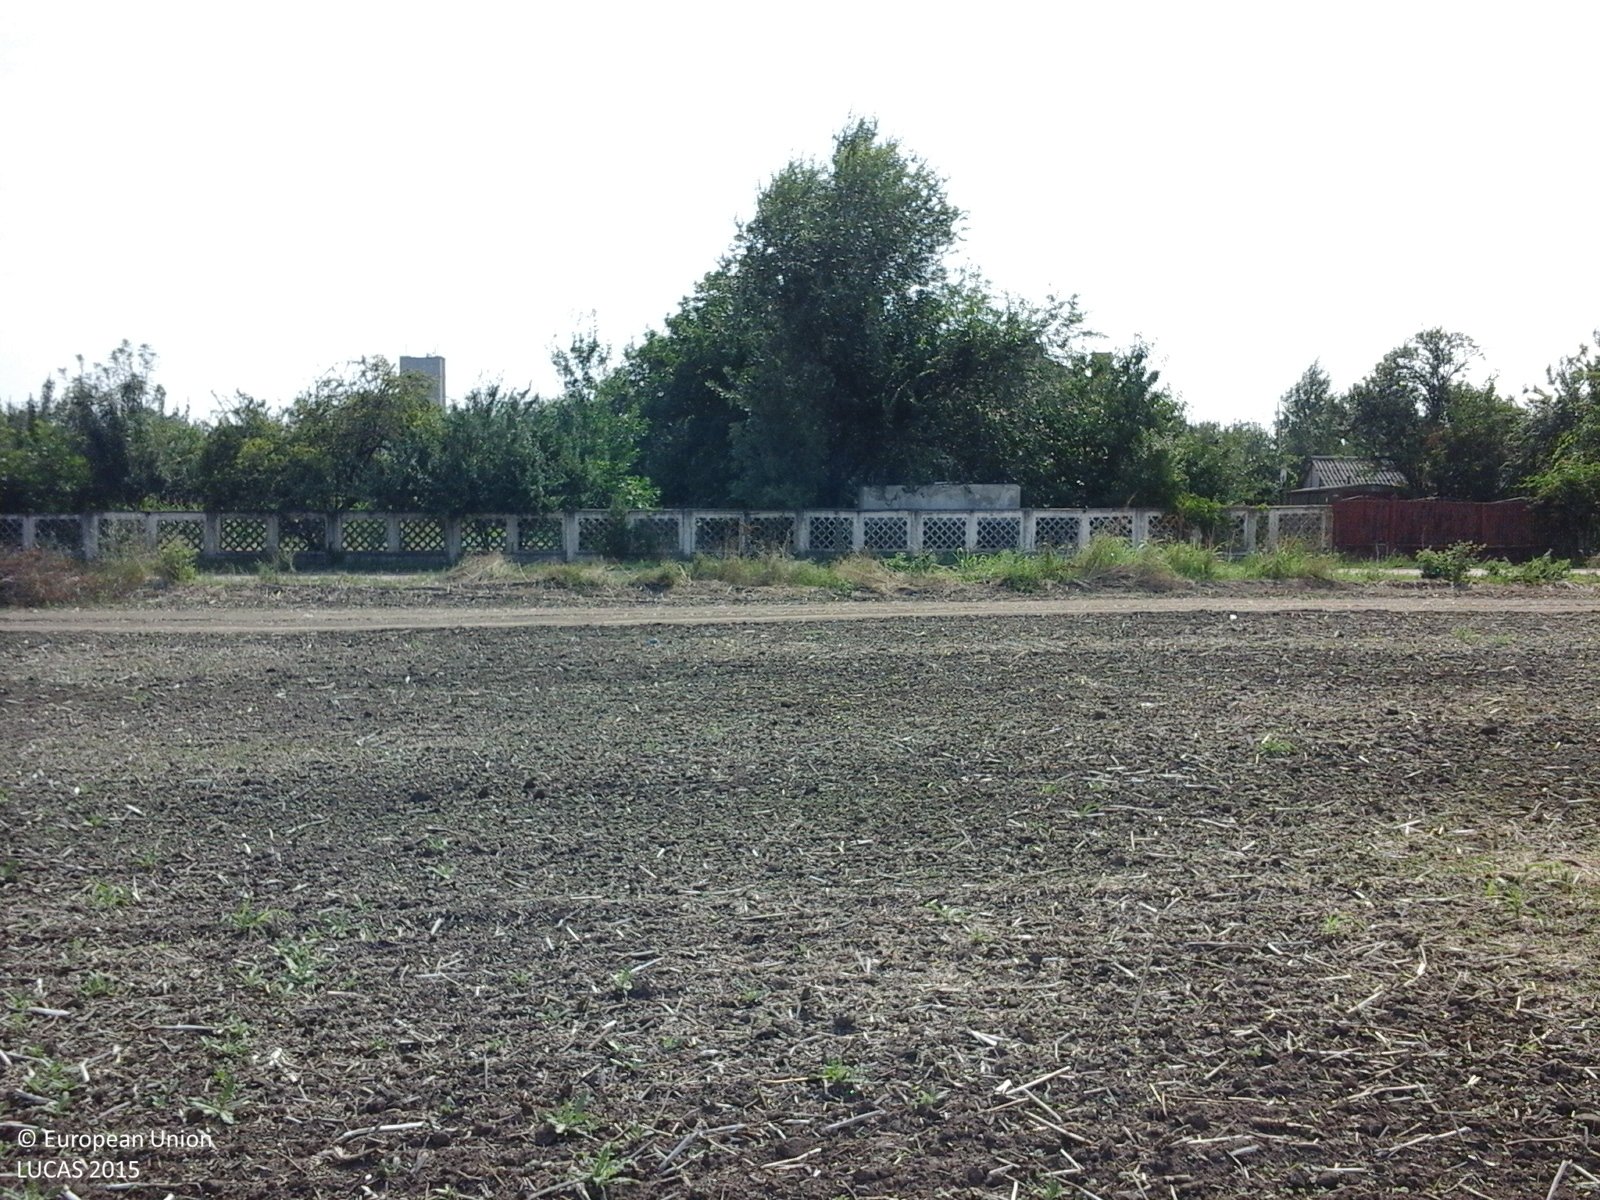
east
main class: Cropland
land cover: Rape and turnip rape
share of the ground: < 10 %
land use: Agriculture (excluding fallow land and kitchen gardens)
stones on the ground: < 10 %
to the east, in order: Rape and turnip rape; Artificial constructions in urban areas
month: July
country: RO
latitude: 44.4223
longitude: 27.5651
